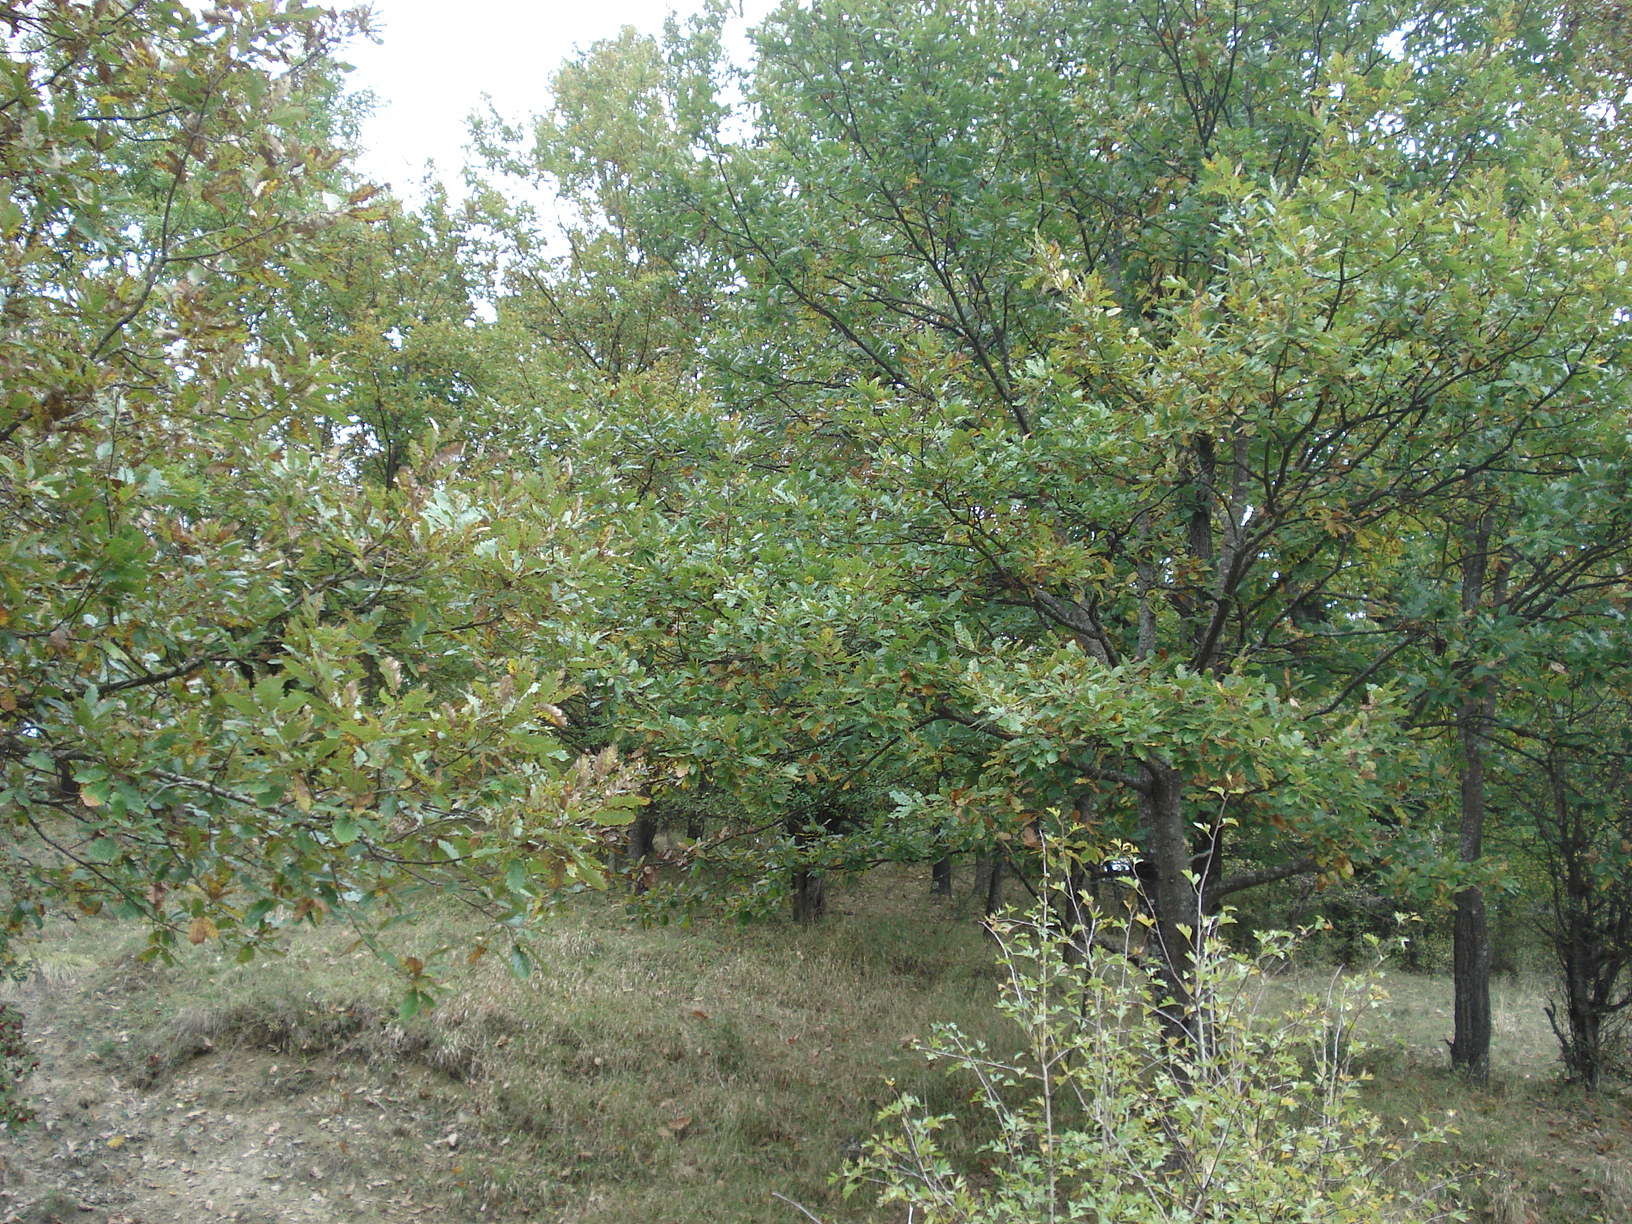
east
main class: Woodland
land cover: Broadleaved woodland
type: mesophytic deciduous forest
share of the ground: 50 - 75 %
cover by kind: broadleaved forest trees 60 %, shrubs 20 %, herbaceous plants 20 %
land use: Semi-natural and natural areas not in use
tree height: > 5 m
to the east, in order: Broadleaved woodland; Grassland with sparse tree/shrub cover; Broadleaved woodland; Tracks; Grassland with sparse tree/shrub cover
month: October
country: BG
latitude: 42.9273
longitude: 25.9266
